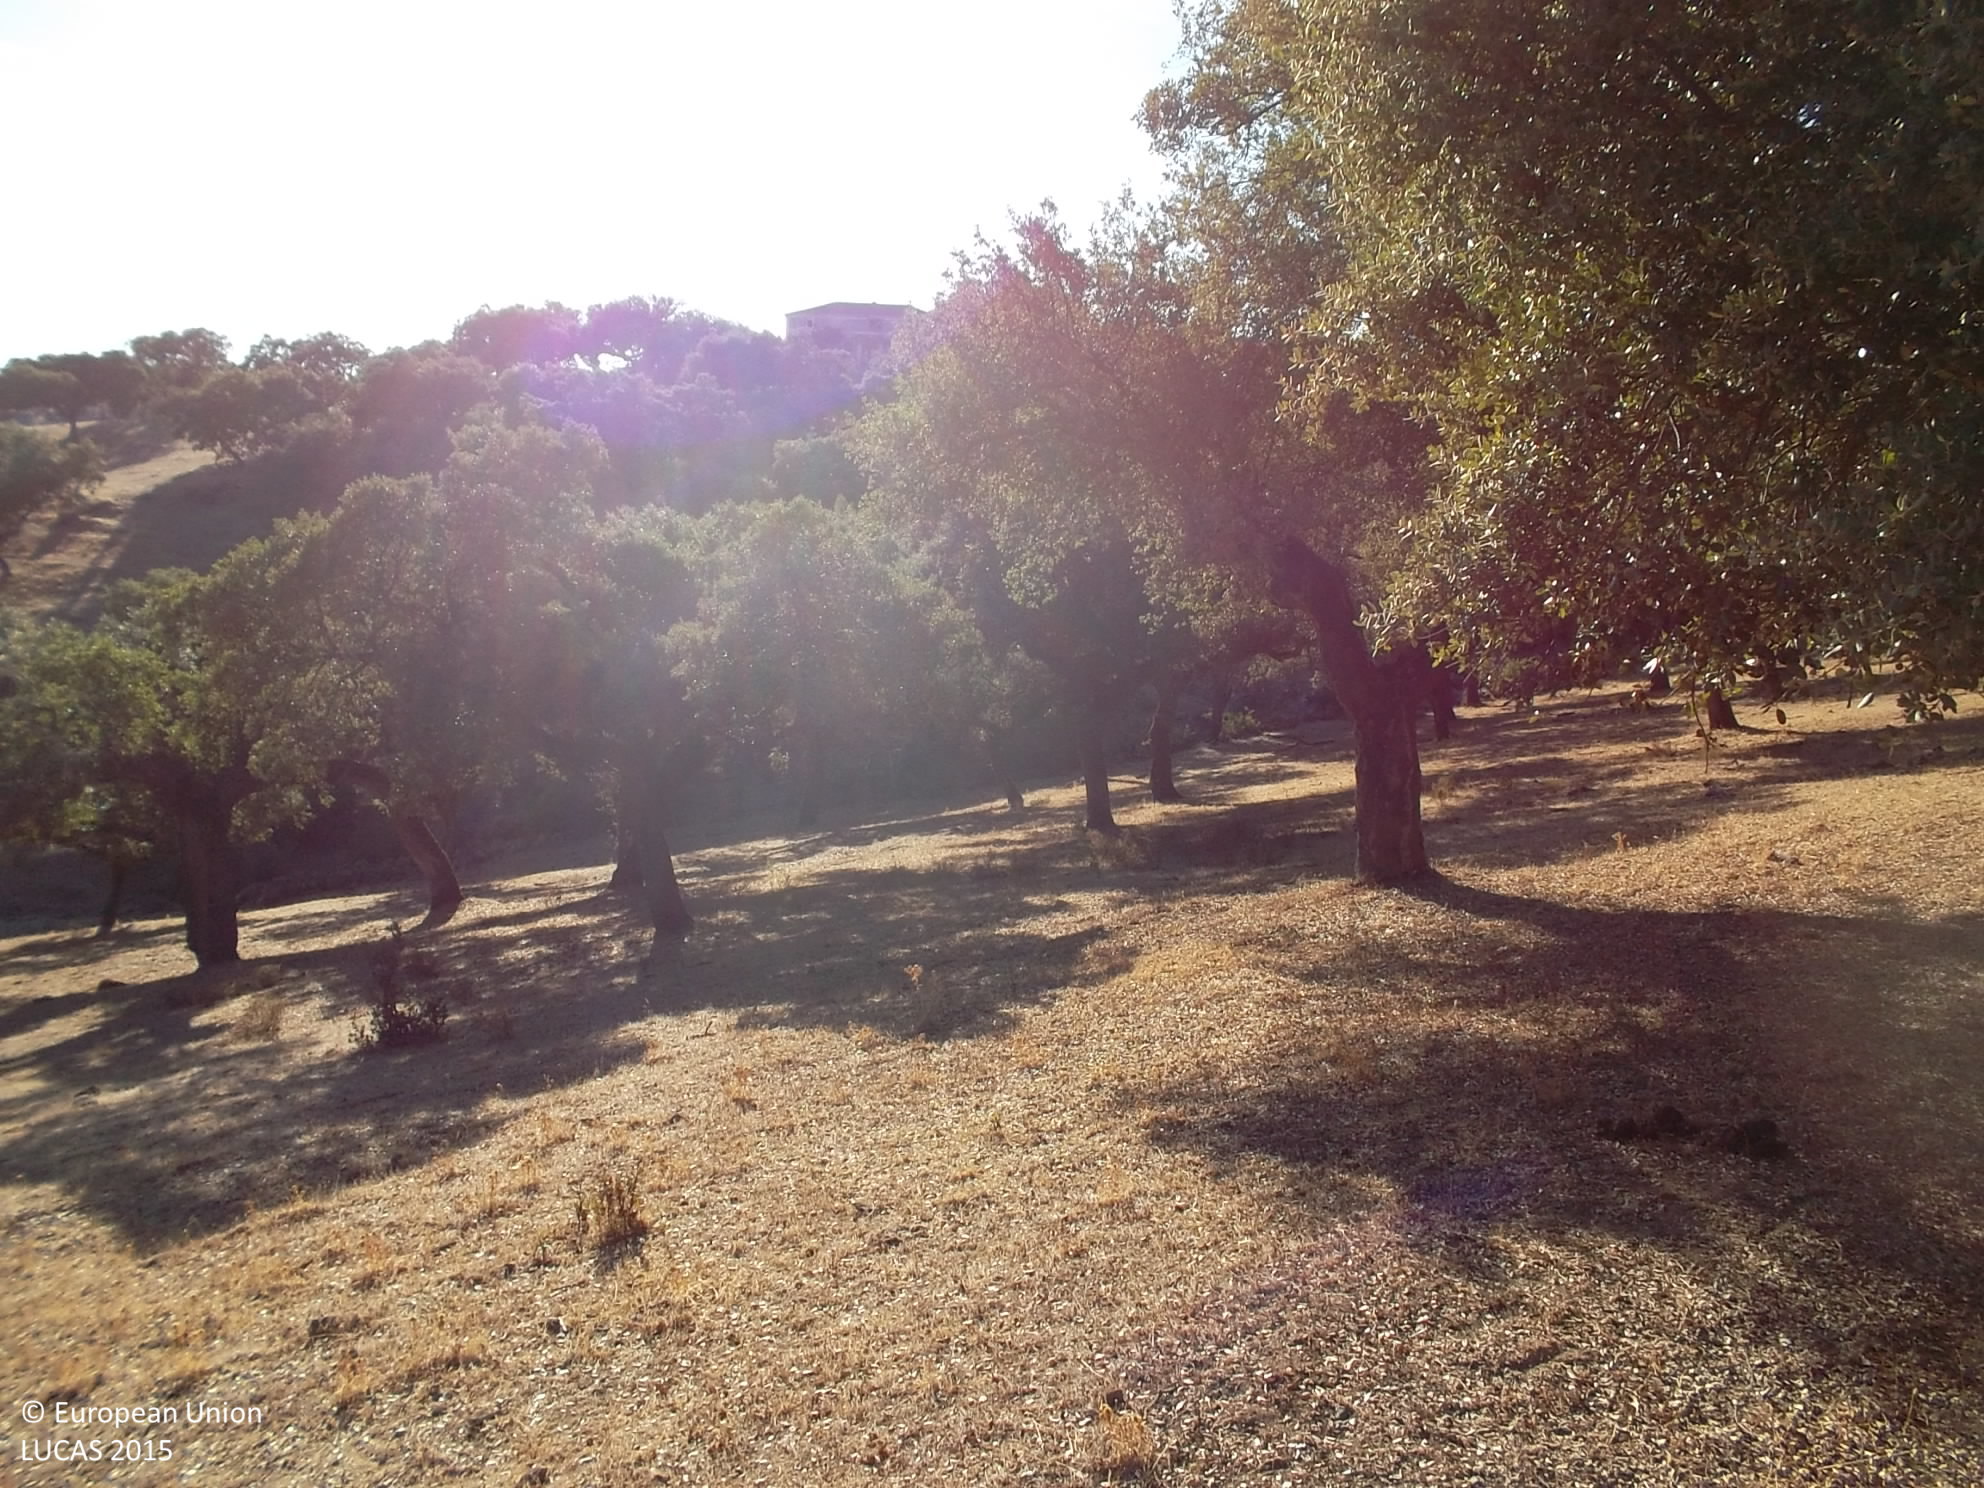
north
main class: Woodland
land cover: Broadleaved woodland
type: broadleaved evergreen forest
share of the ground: 50 - 75 %
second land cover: Grassland without tree/shrub cover
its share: > 75 %
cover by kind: broadleaved forest trees 50 %, herbaceous plants 50 %
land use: Forestry
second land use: Agriculture (excluding fallow land and kitchen gardens)
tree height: > 5 m
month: August
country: ES
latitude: 38.4271
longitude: -6.6531
